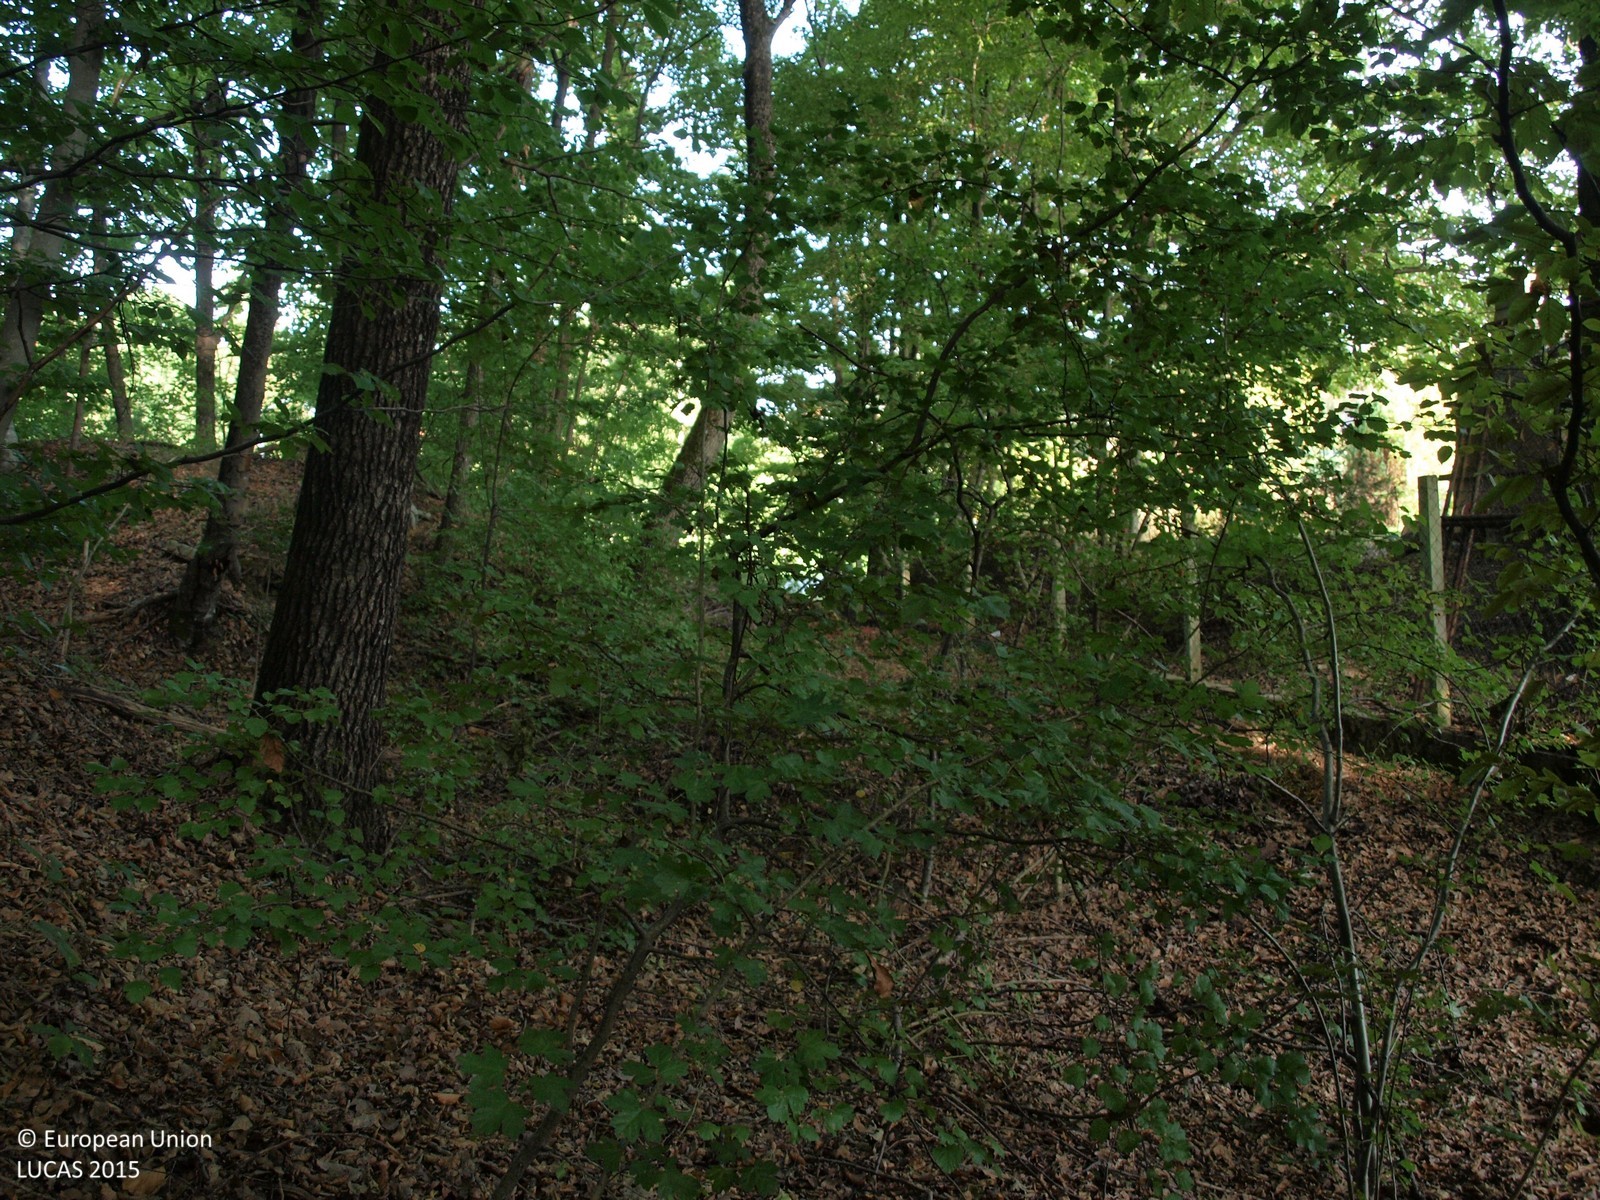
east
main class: Woodland
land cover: Broadleaved woodland
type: mesophytic deciduous forest
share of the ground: > 75 %
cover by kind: broadleaved forest trees 100 %
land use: Forestry
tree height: > 5 m
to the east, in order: Broadleaved woodland; Fences; Nuts trees; Fences; Paved roads, cycling and walking lanes; Grass margins; Vineyards; Apple fruit; Artificial constructions in urban areas; Grassland without tree/shrub cover; Spontaneously vegetated surfaces; Apple fruit
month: September
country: HR
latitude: 45.6012
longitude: 16.0616
